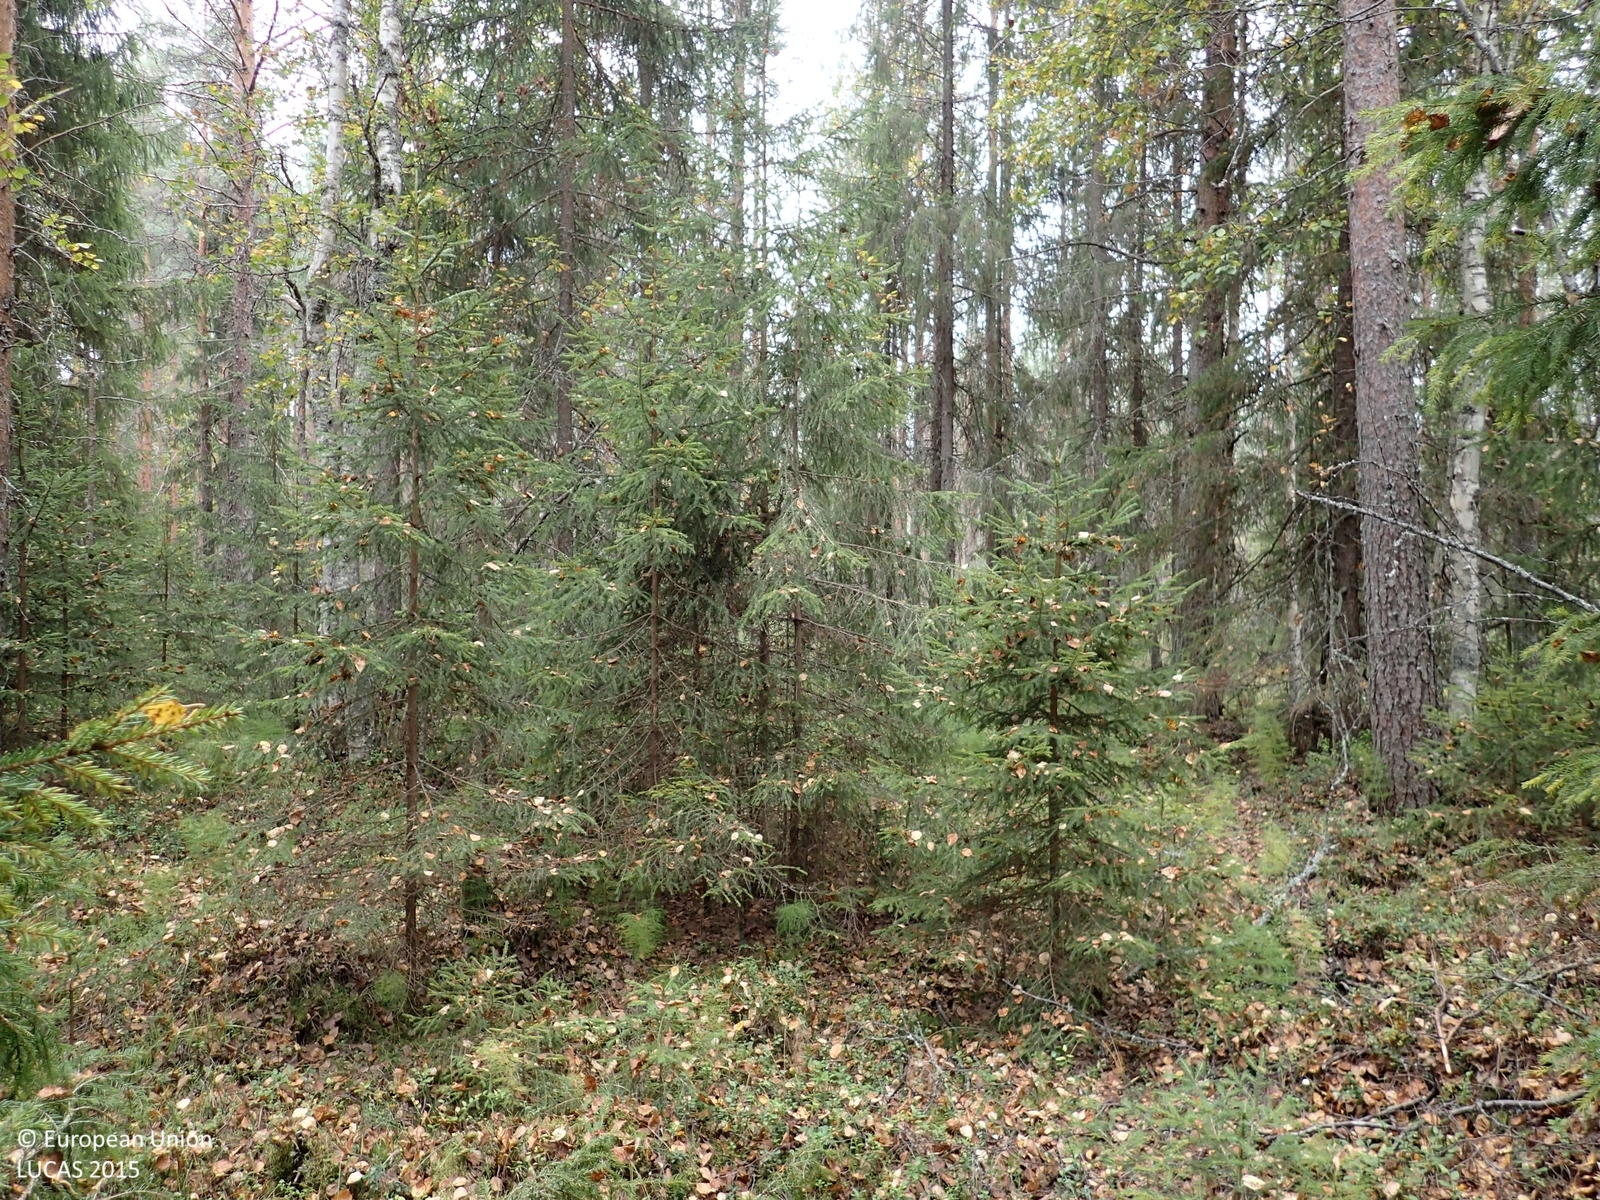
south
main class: Woodland
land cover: Other mixed woodland
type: boreal forest
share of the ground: > 75 %
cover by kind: coniferous forest trees 60 %, broadleaved forest trees 20 %, shrubs 10 %, herbaceous plants 5 %, lichens and mosses 5 %
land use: Forestry
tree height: > 5 m
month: September
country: FI
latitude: 63.0395
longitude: 25.6697
